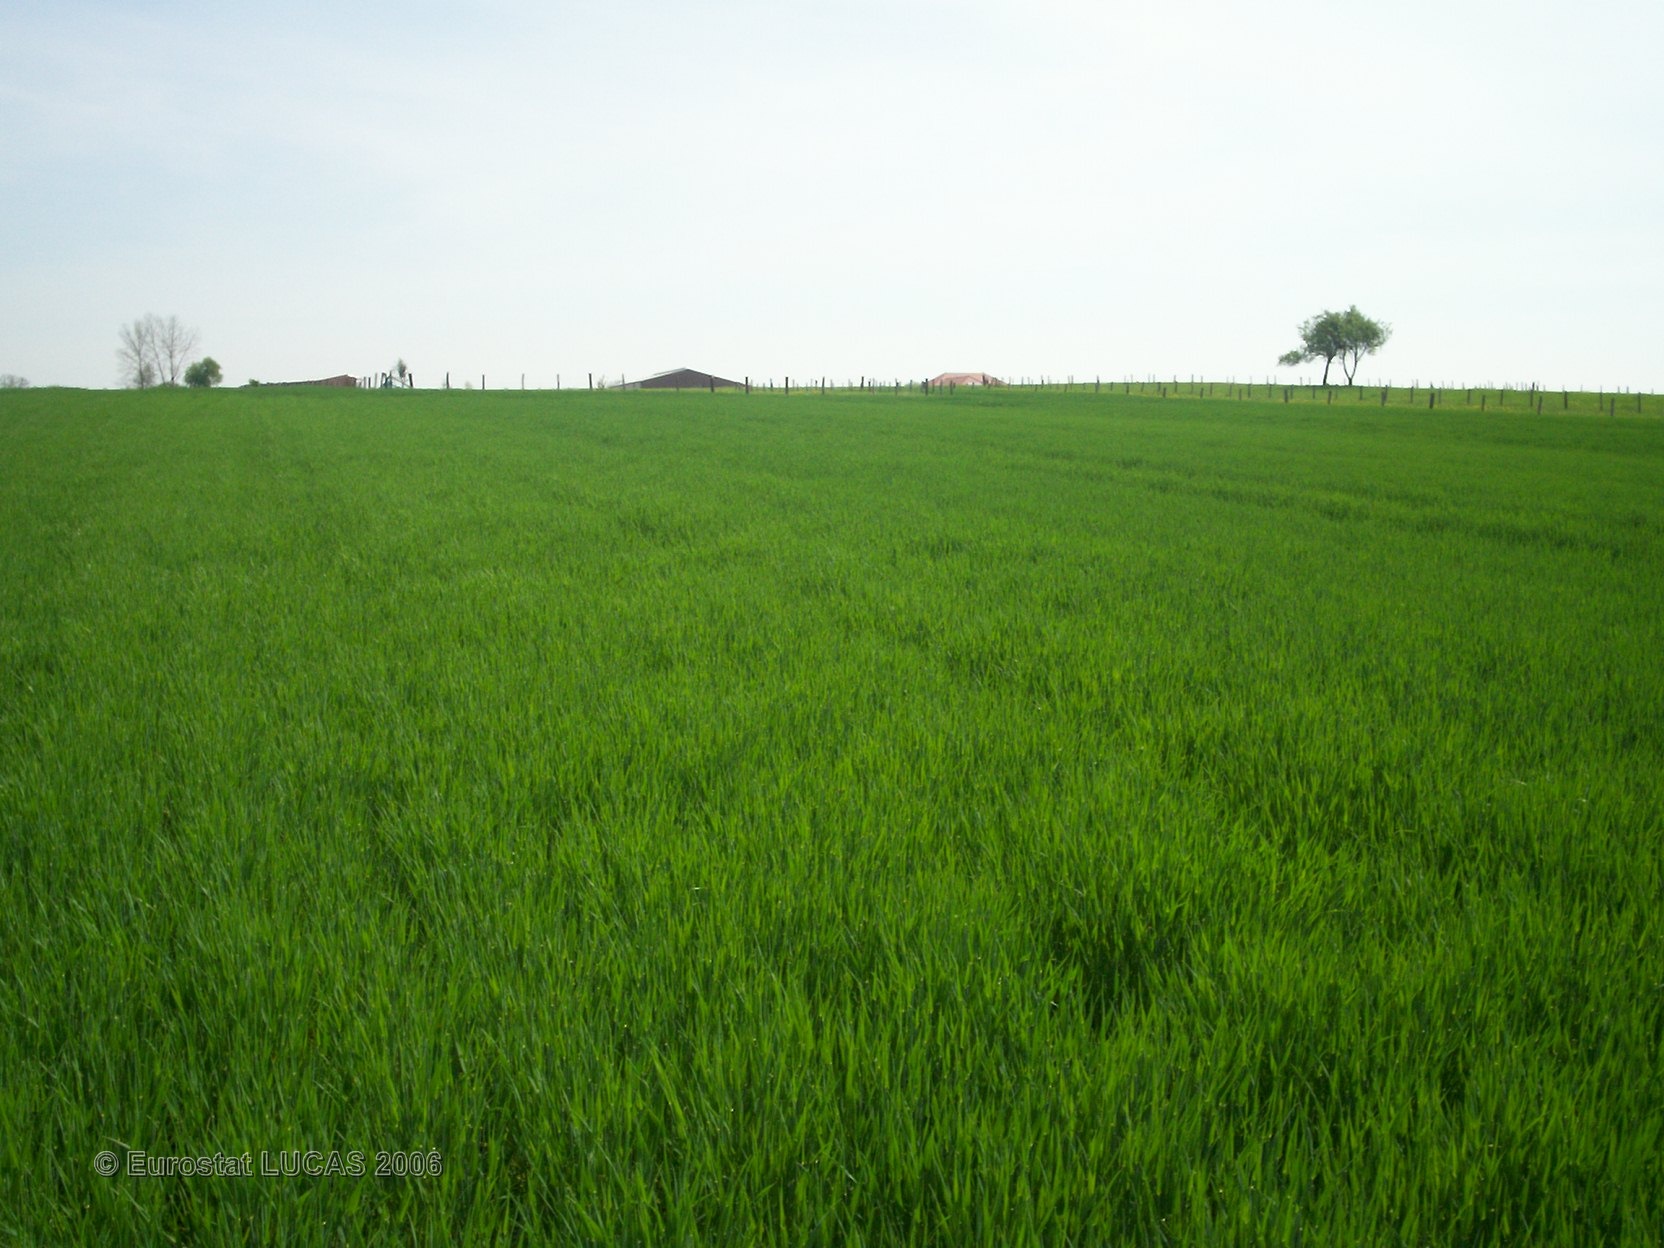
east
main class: Cropland
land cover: Barley
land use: Agriculture (excluding fallow land and kitchen gardens)
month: May
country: FR
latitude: 48.9392
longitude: 7.0106
